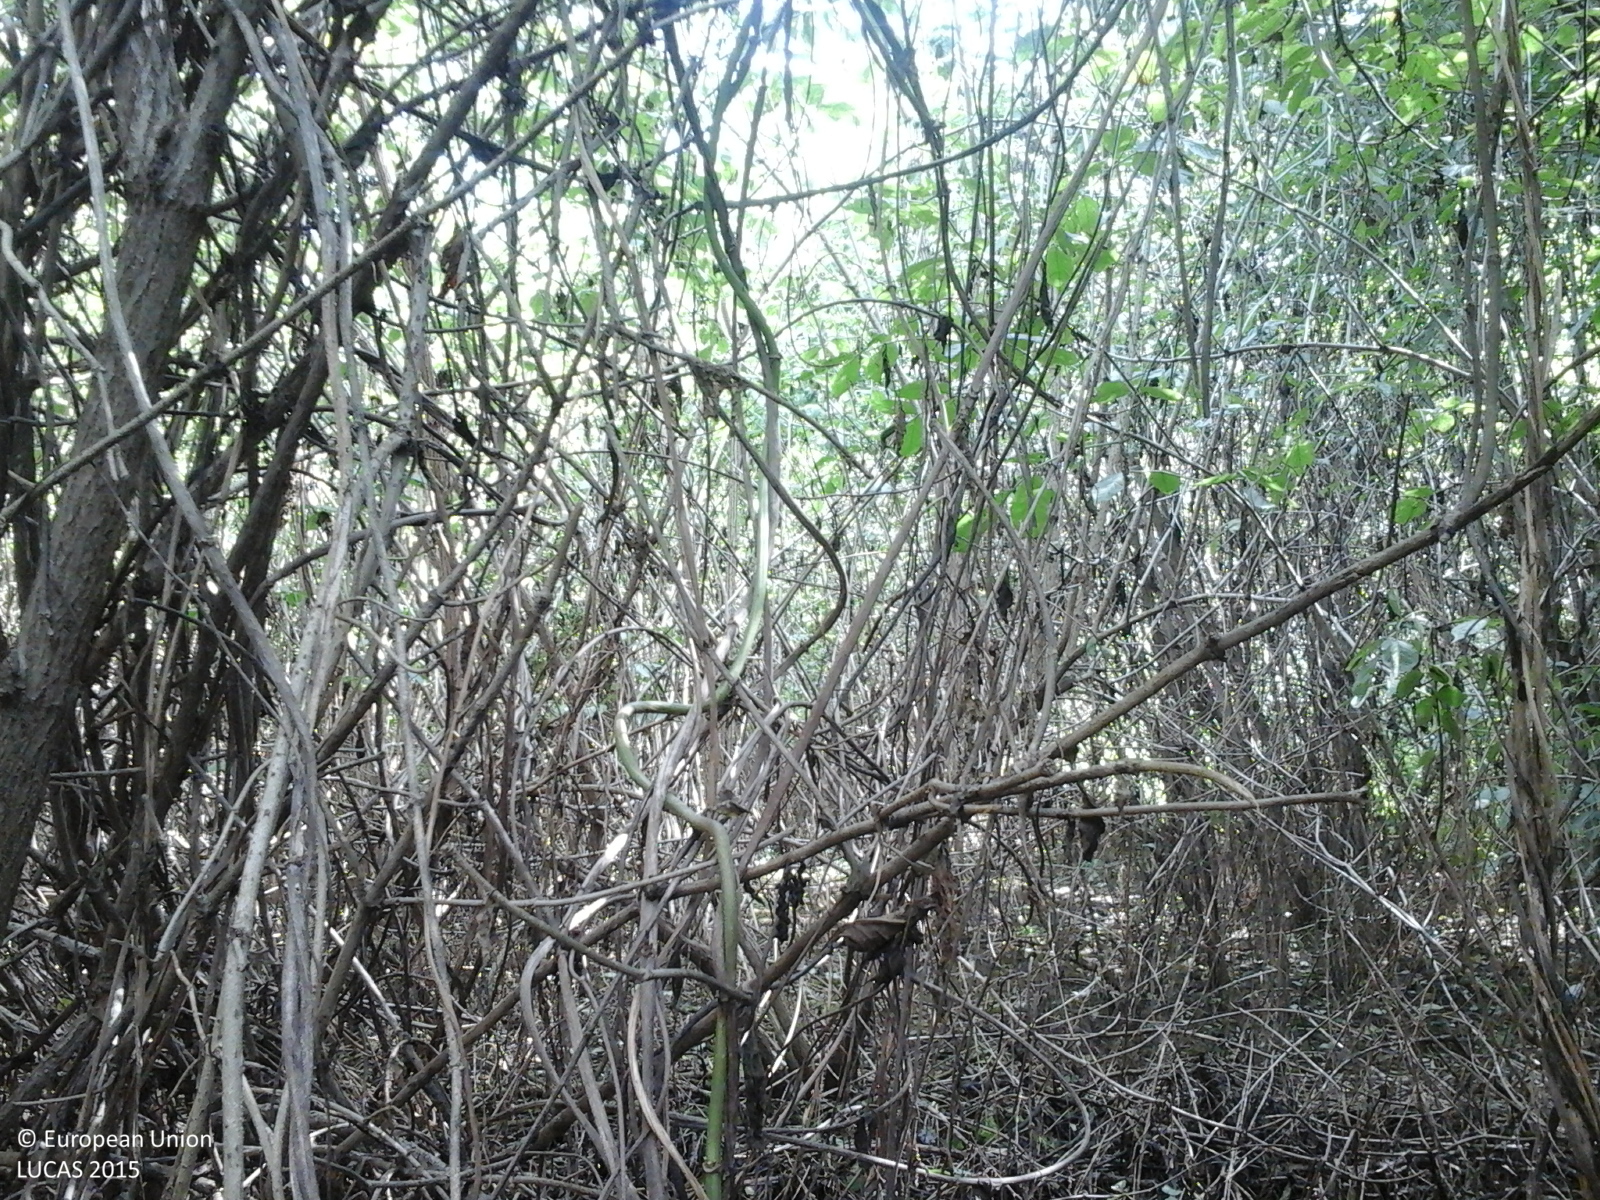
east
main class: Woodland
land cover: Broadleaved woodland
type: non-riverine alder, birch or aspen forest
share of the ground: > 75 %
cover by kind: broadleaved forest trees 100 %
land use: Forestry
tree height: > 5 m
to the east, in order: Broadleaved woodland; Tracks; Shrubland with sparse tree cover; Spontaneously vegetated surfaces; Maize; Shrubland with sparse tree cover
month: September
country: RO
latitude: 47.3364
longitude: 23.4788
